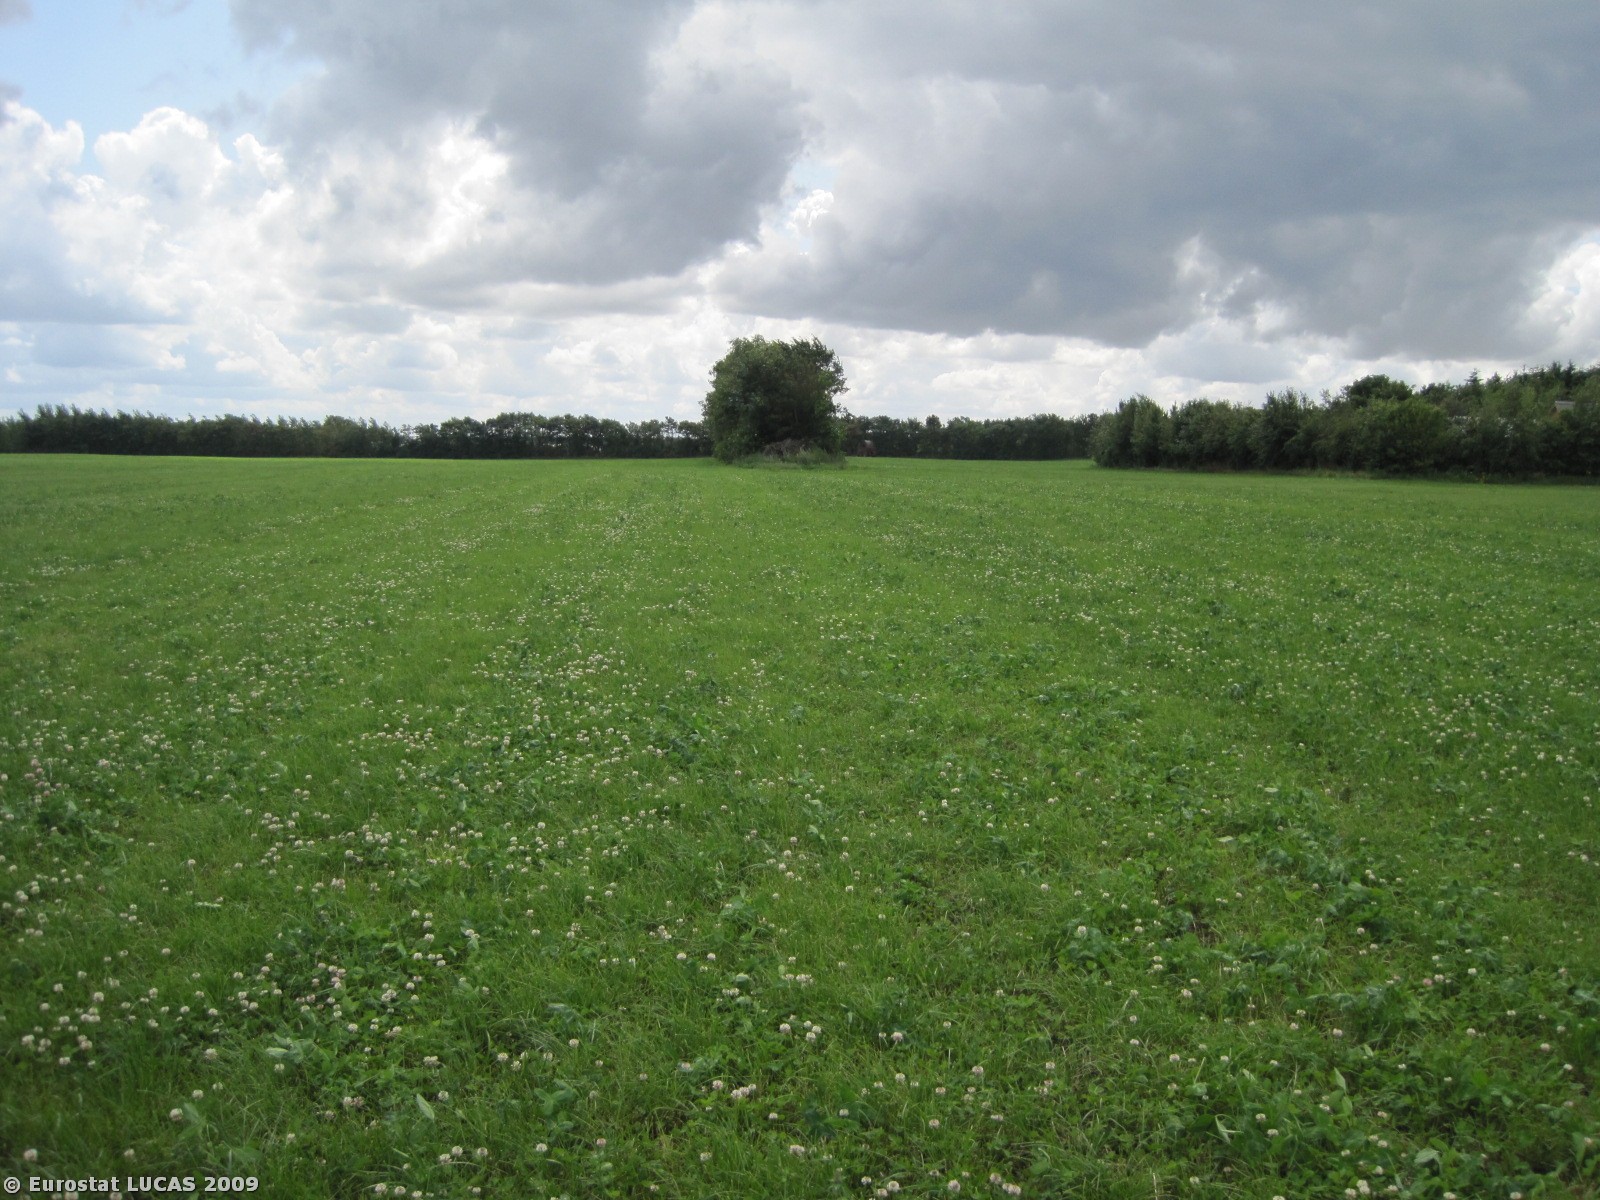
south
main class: Cropland
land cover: Temporary grasslands
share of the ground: > 75 %
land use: Agriculture (excluding fallow land and kitchen gardens)
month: July
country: DK
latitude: 56.3992
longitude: 8.9482
